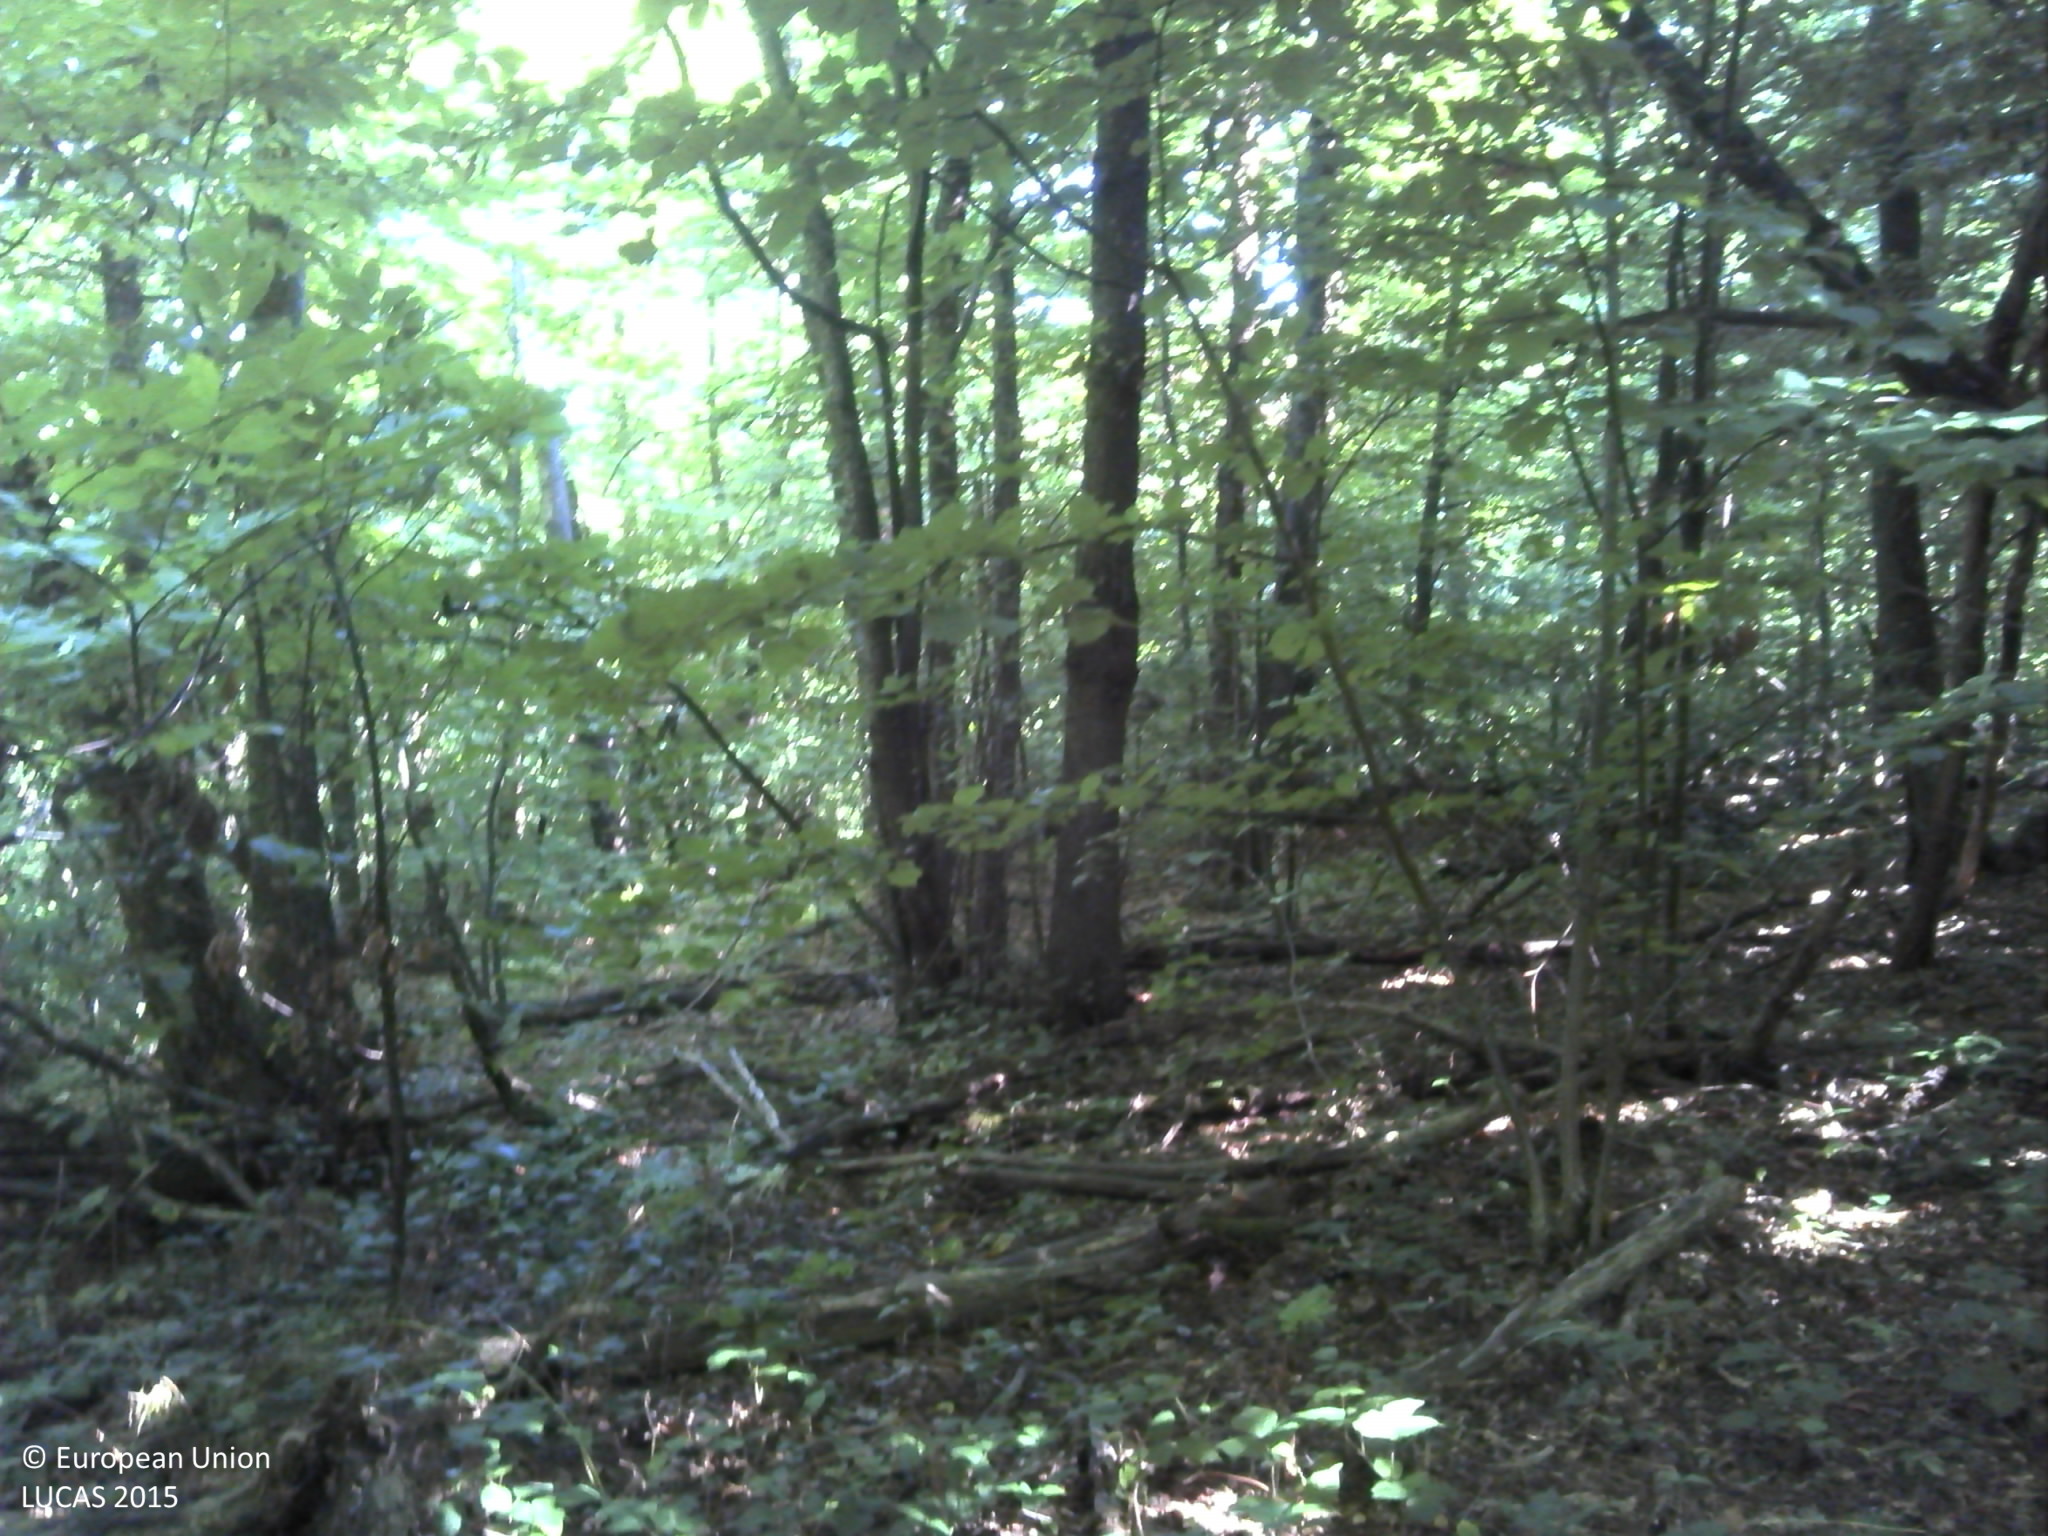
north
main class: Woodland
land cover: Broadleaved woodland
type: beech forest
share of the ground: > 75 %
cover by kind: broadleaved forest trees 100 %
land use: Forestry
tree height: > 5 m
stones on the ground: < 10 %
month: August
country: HR
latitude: 45.2048
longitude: 16.3498
